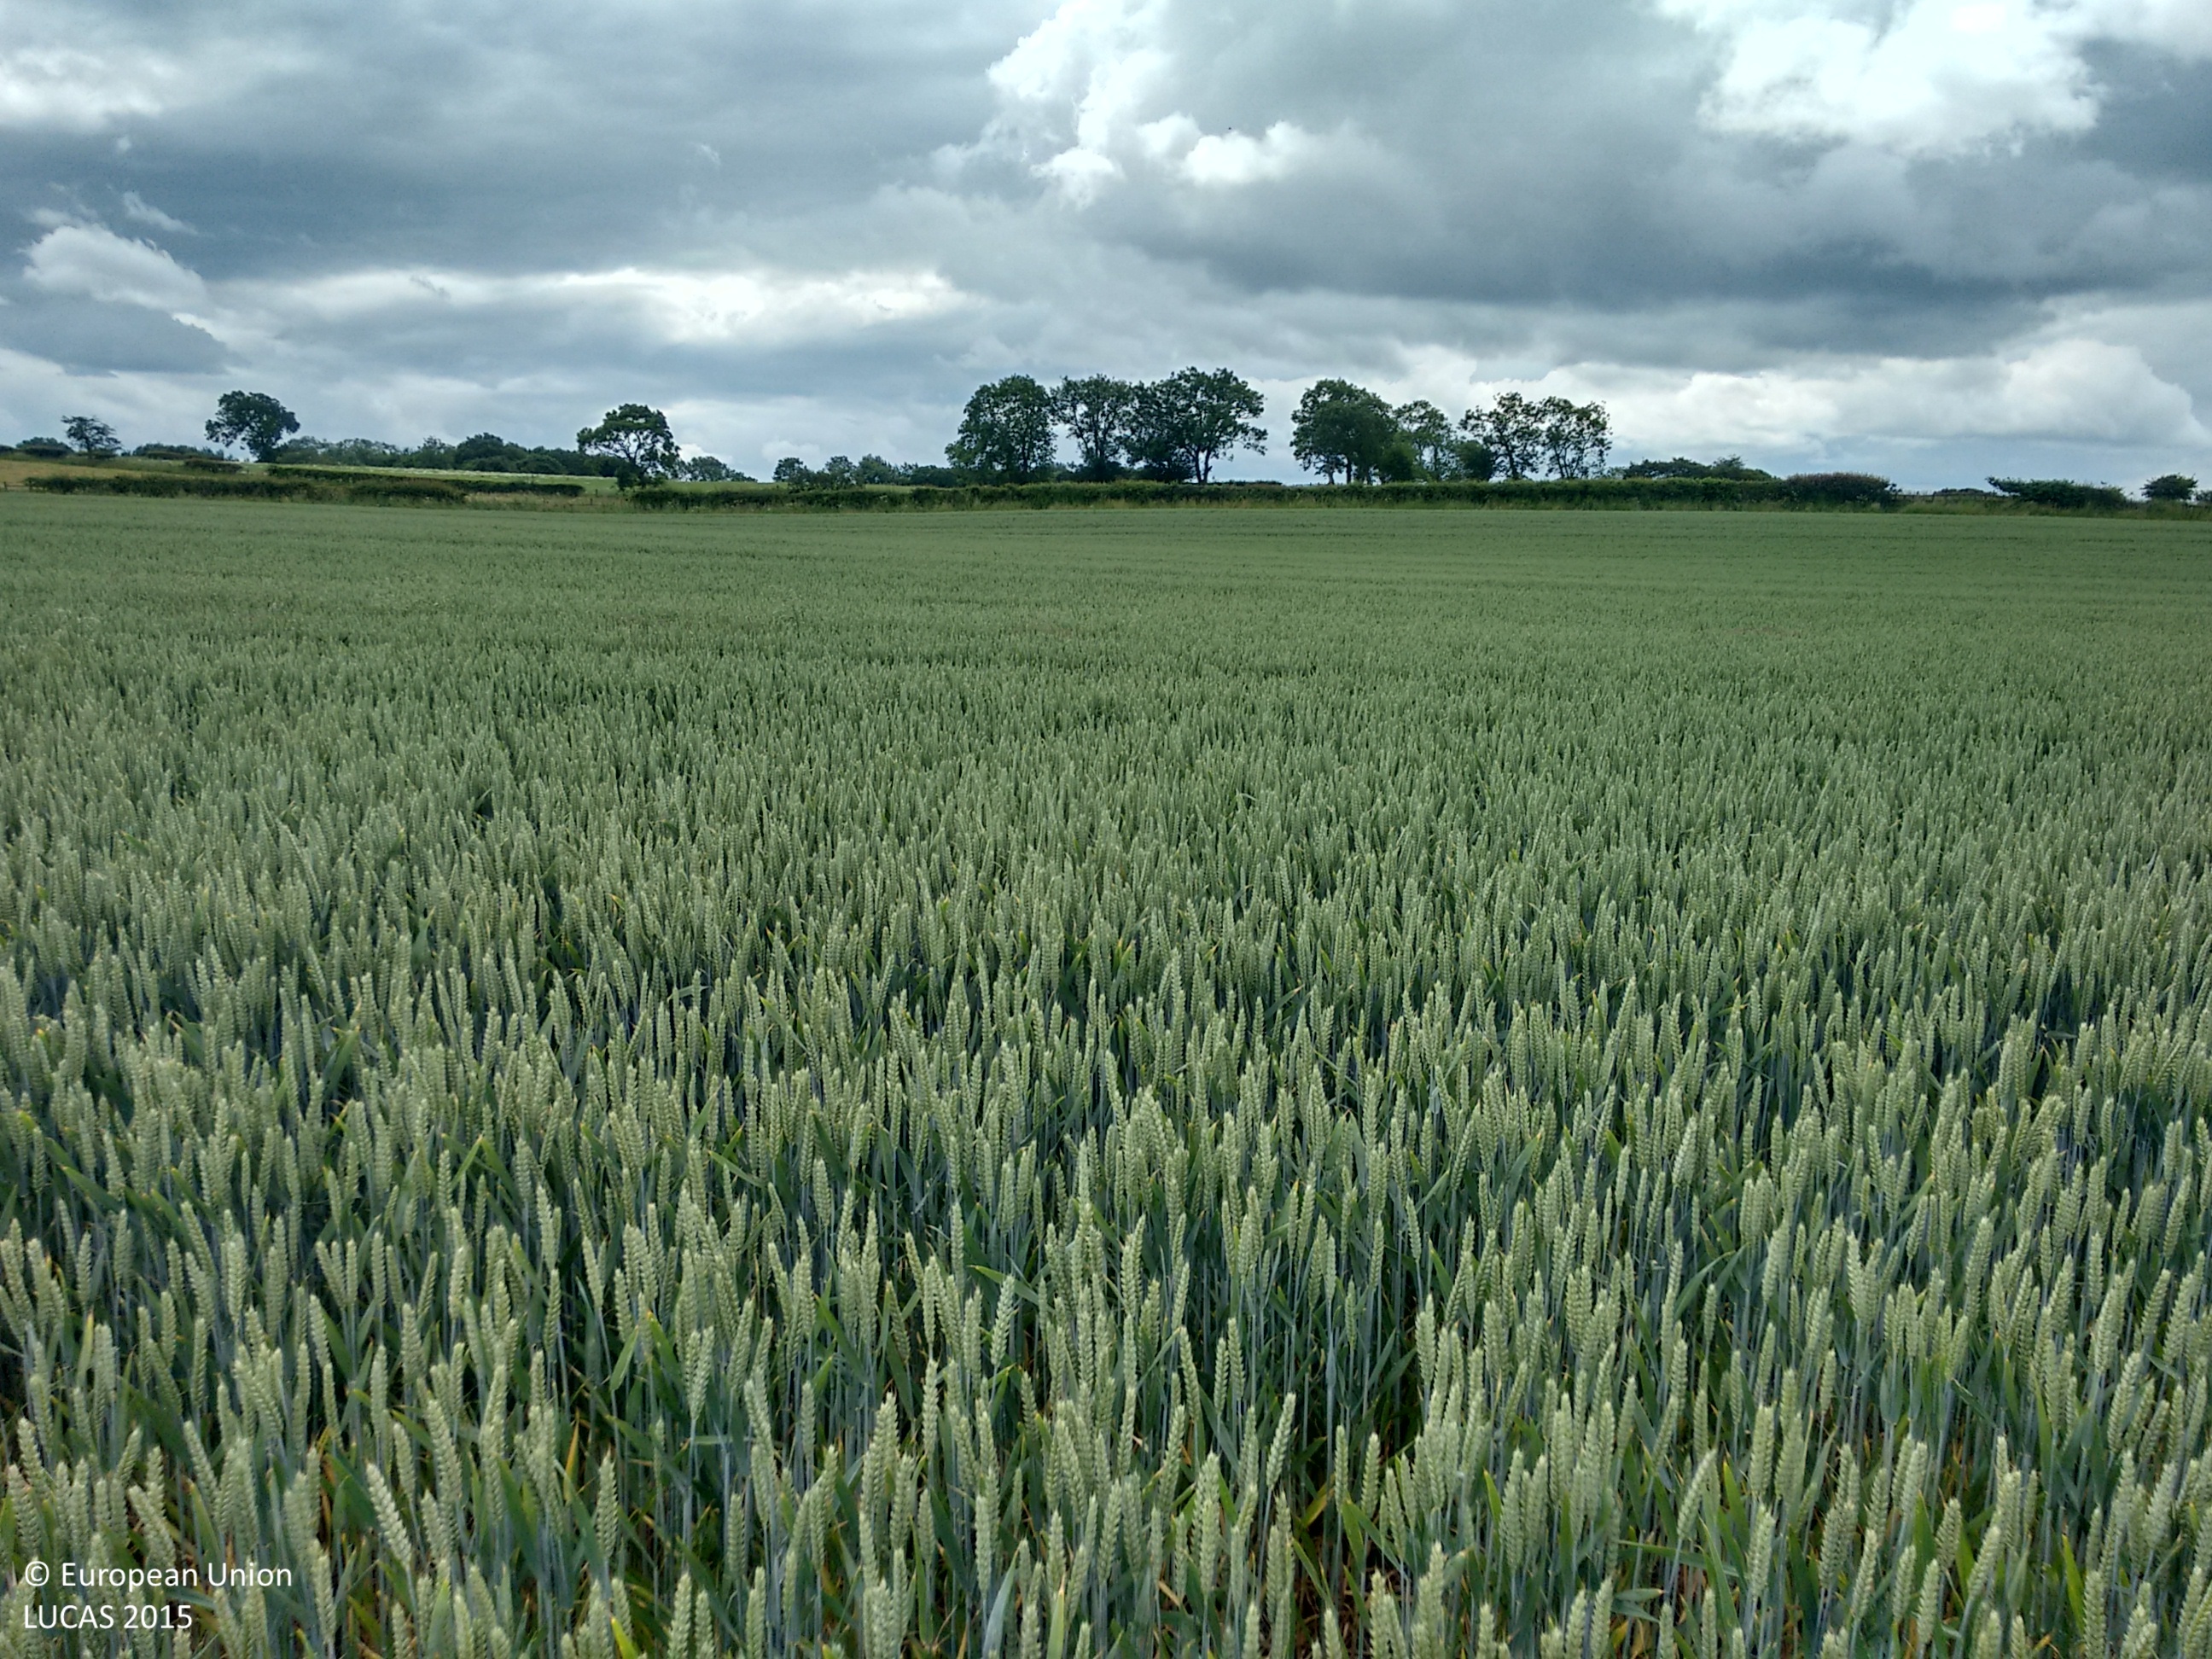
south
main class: Cropland
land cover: Barley
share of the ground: > 75 %
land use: Agriculture (excluding fallow land and kitchen gardens)
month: July
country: GB
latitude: 54.5947
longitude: -1.5171
